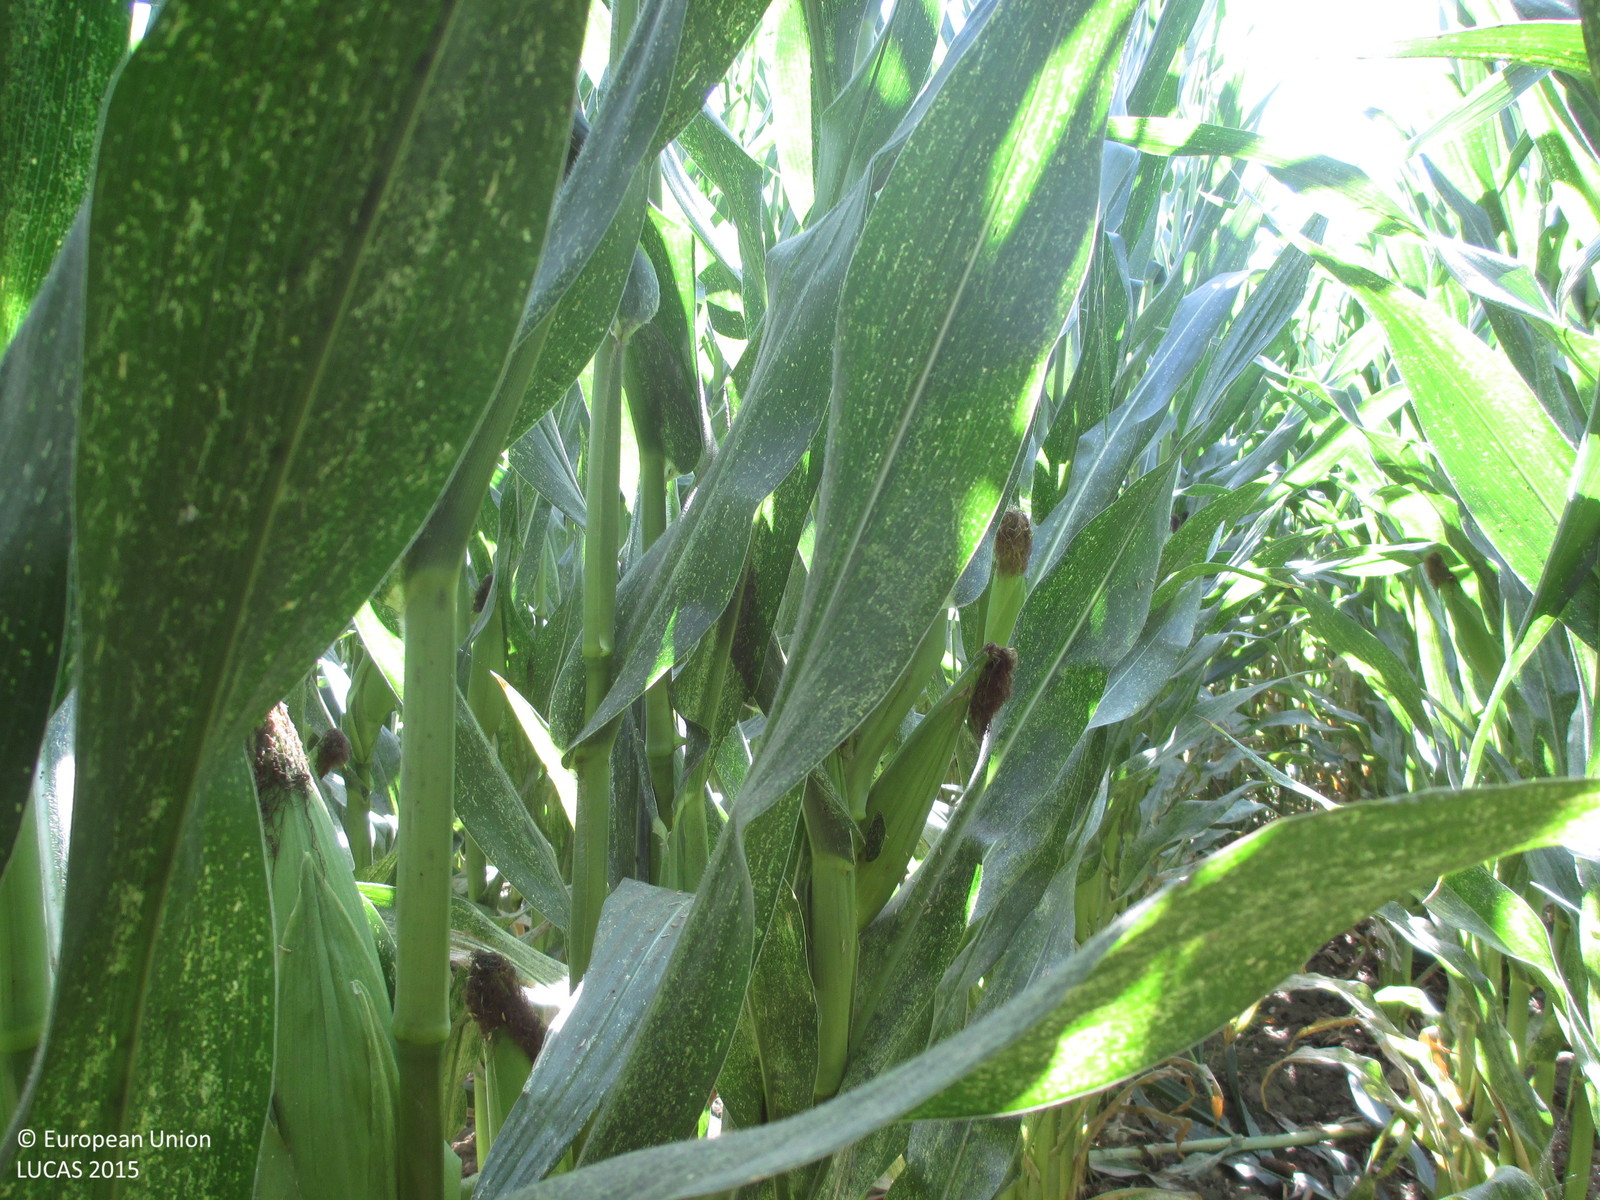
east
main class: Cropland
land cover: Maize
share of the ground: > 75 %
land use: Agriculture (excluding fallow land and kitchen gardens)
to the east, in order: Maize; Tracks; Shruby margins; Inland fresh running water; Shruby margins; Tracks; Shrubland without tree cover; Electric lines; Shrubland without tree cover; Ditches and canals; Maize; Electric lines; Maize; Tracks; Maize
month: July
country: ES
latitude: 42.0130
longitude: 0.1893
